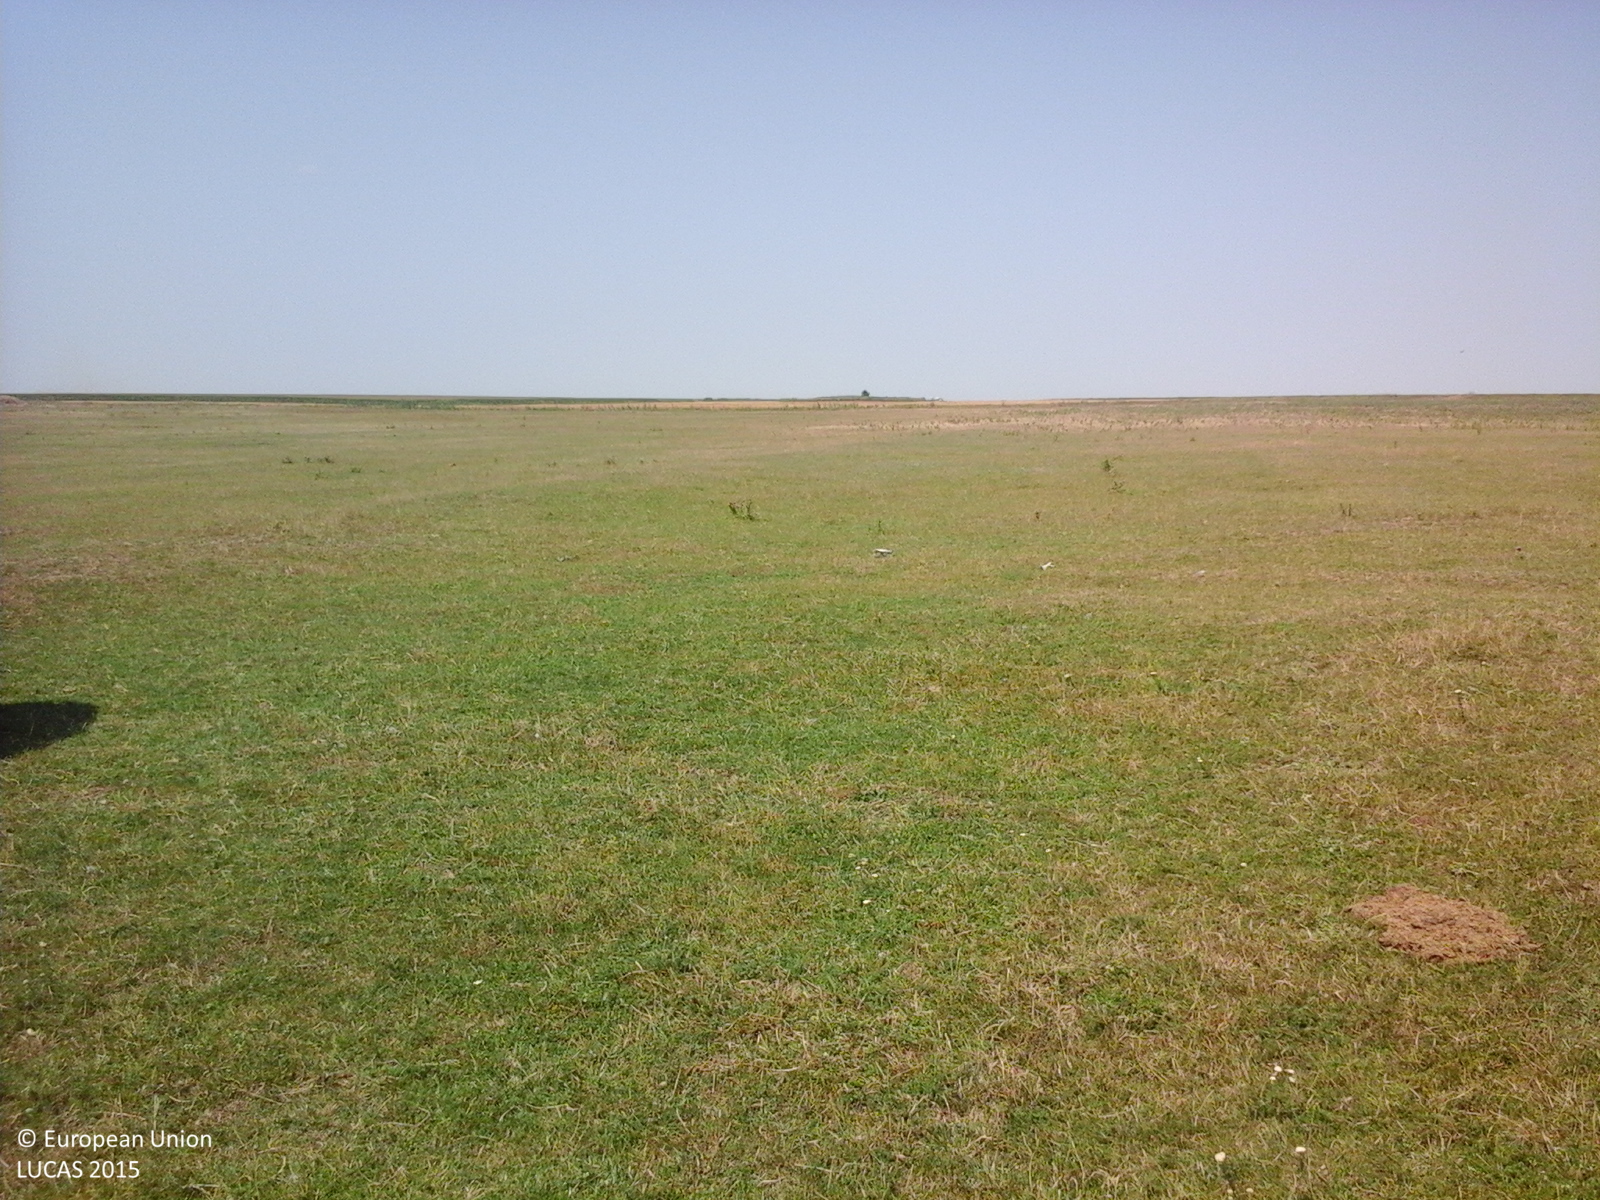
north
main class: Grassland
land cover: Grassland without tree/shrub cover
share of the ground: > 75 %
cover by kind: herbaceous plants 100 %
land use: Agriculture (excluding fallow land and kitchen gardens)
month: July
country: RO
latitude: 44.7369
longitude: 27.1197
